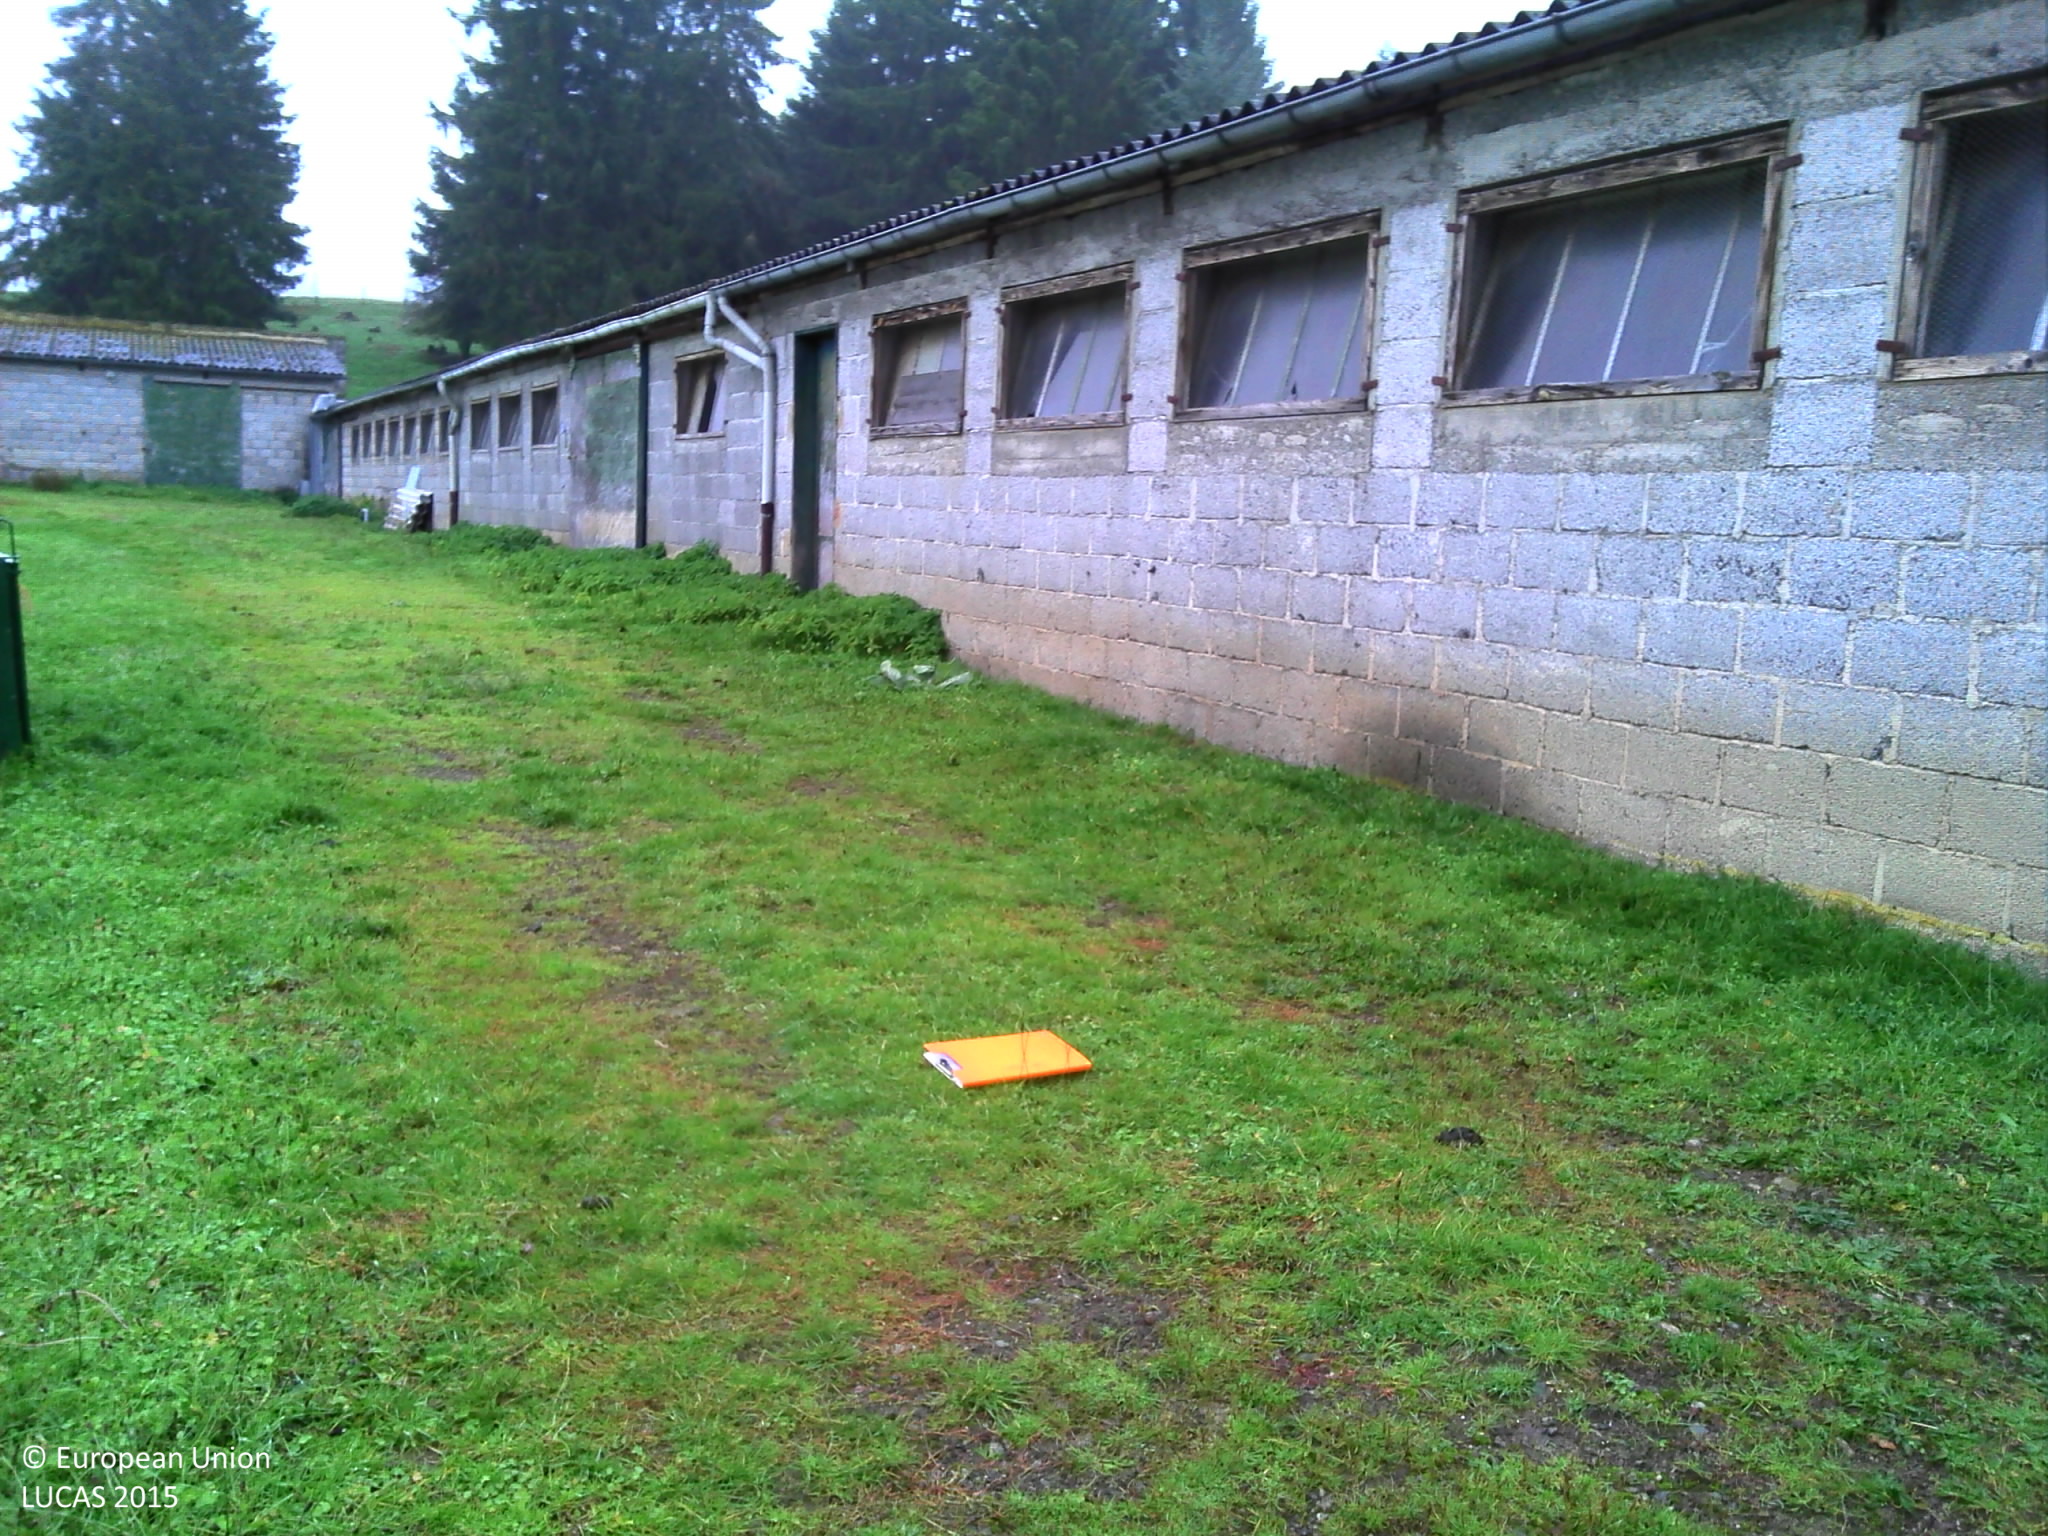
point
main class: Grassland
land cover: Grassland without tree/shrub cover
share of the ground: > 75 %
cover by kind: herbaceous plants 85 %, unconsolidated bare surface 15 %
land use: Agriculture (excluding fallow land and kitchen gardens)
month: October
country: FR
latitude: 45.7477
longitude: 2.8134
